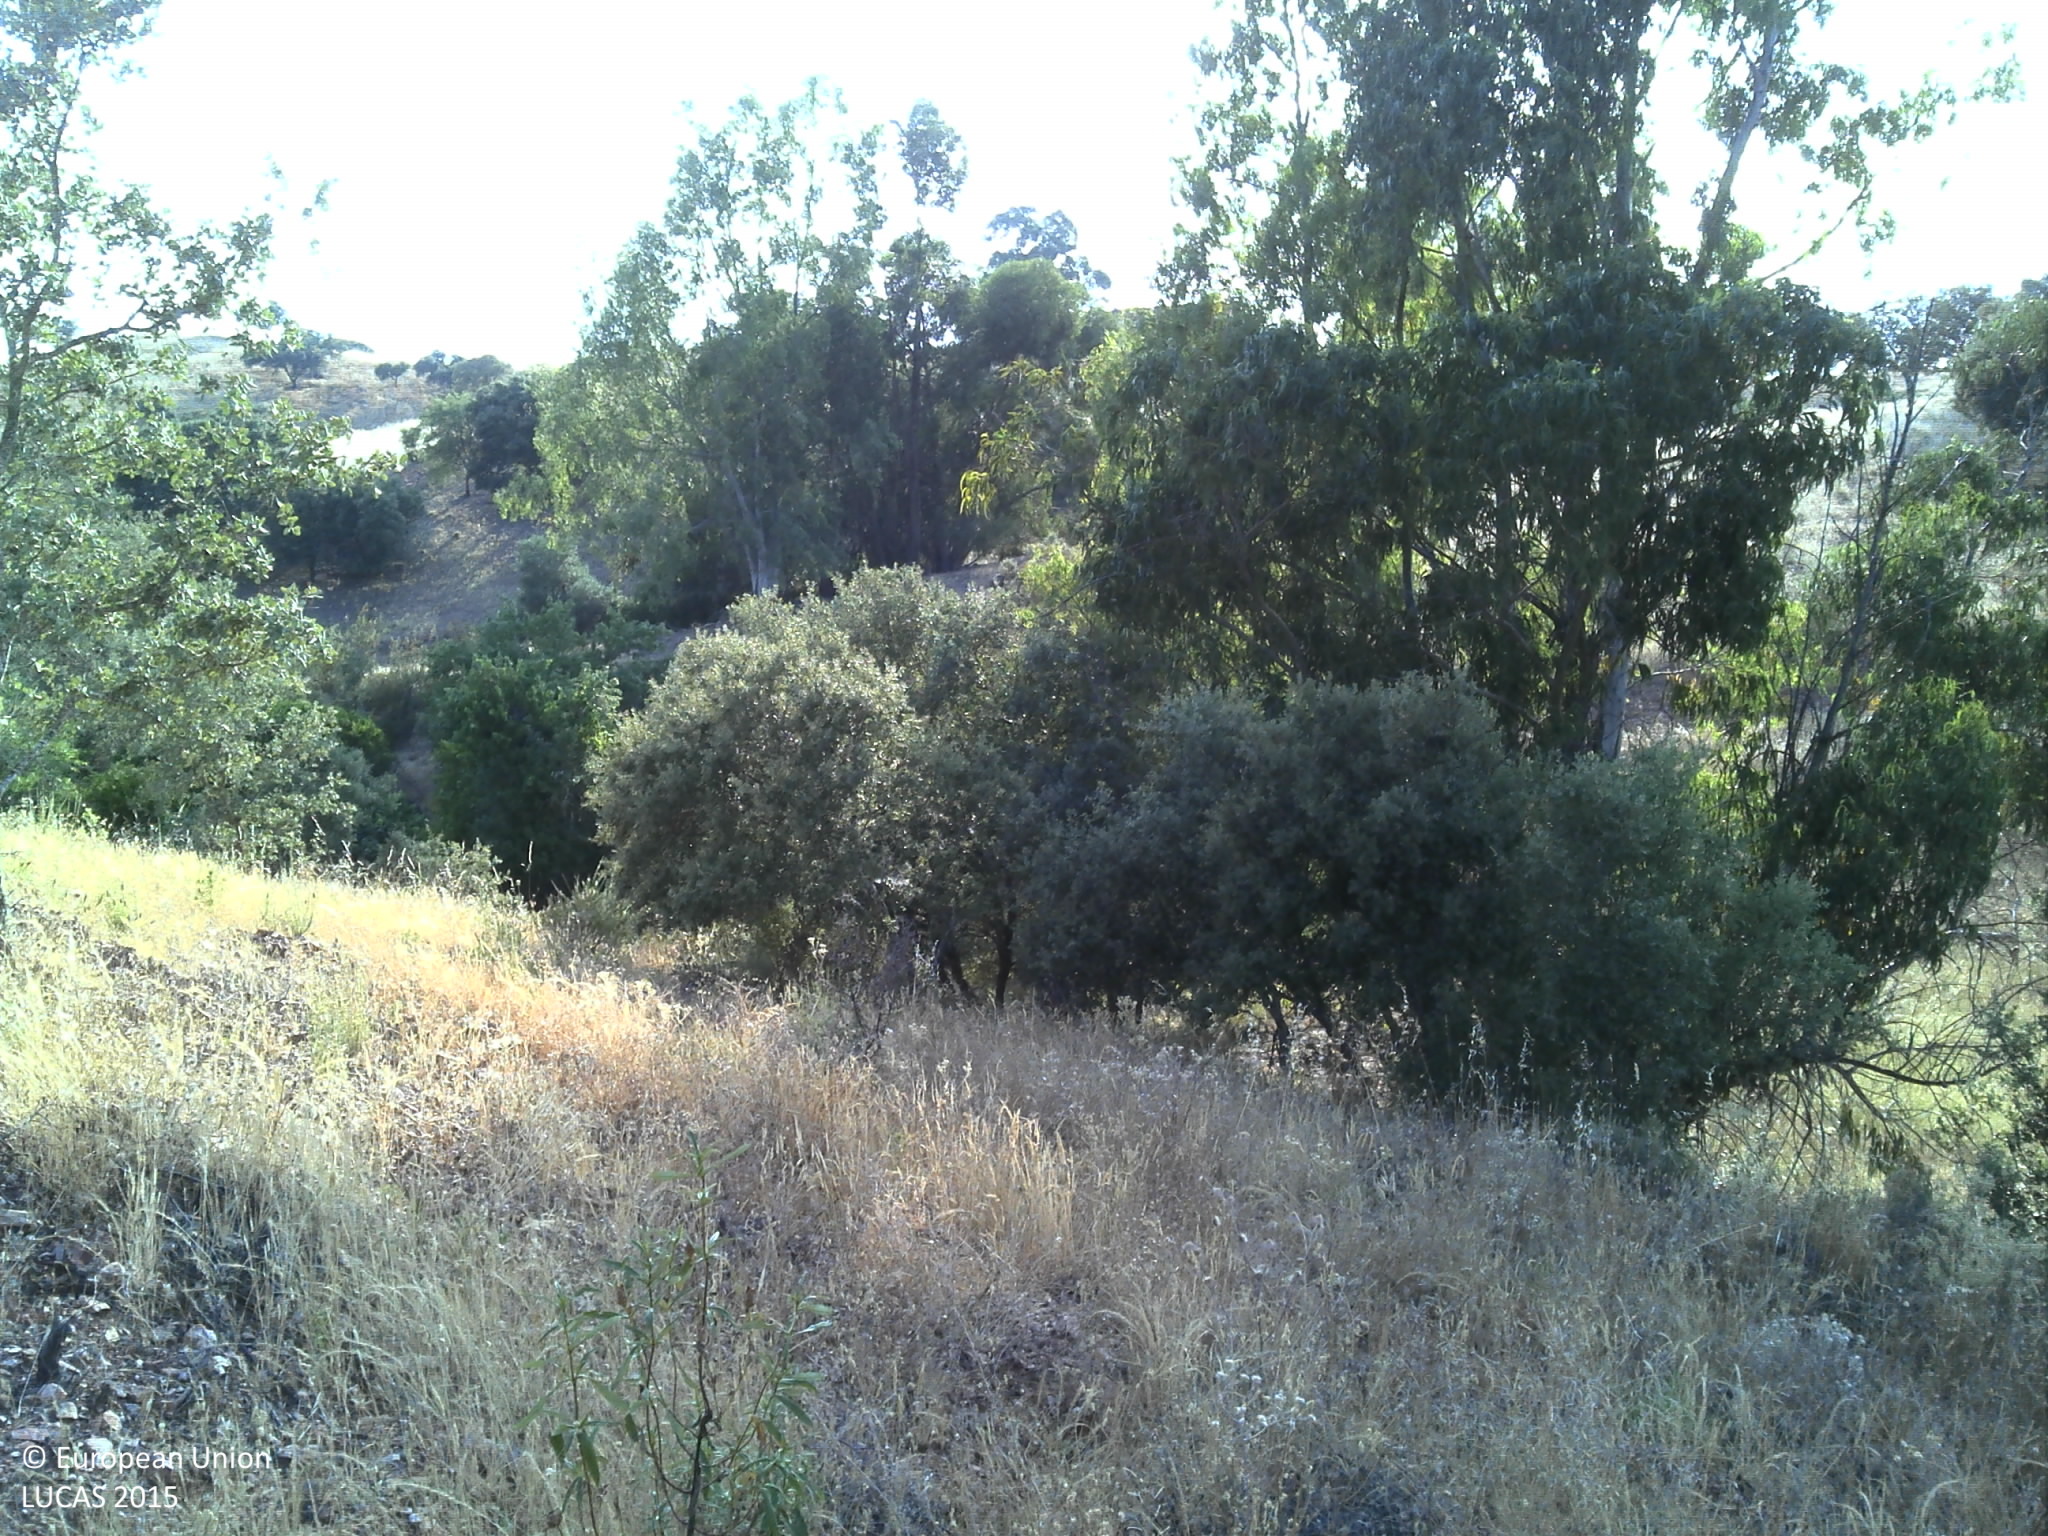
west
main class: Woodland
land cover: Broadleaved woodland
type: broadleaved evergreen forest
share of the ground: 25 - 50 %
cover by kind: herbaceous plants 50 %, broadleaved forest trees 25 %, unconsolidated bare surface 15 %, shrubs 10 %
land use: Forestry
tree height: < 5 m
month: June
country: PT
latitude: 37.7528
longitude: -7.6207
